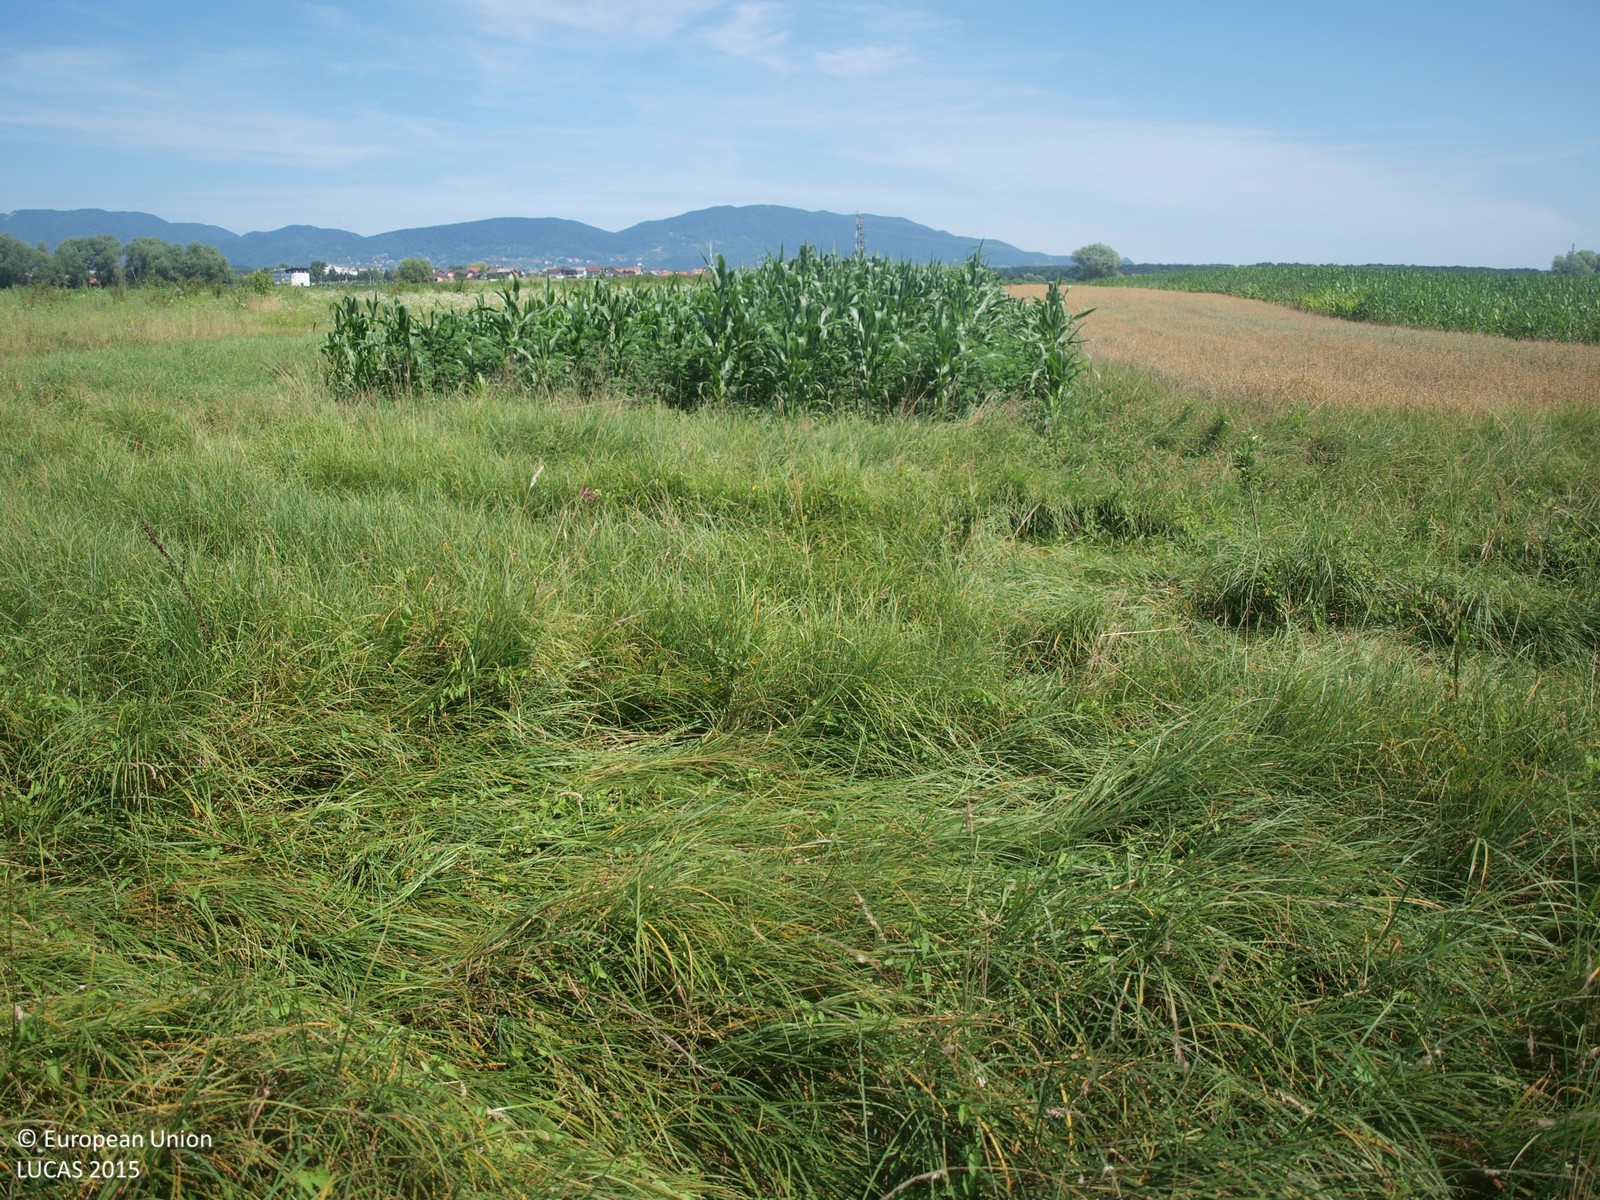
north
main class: Grassland
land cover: Grassland without tree/shrub cover
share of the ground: > 75 %
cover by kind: herbaceous plants 100 %
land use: Agriculture (excluding fallow land and kitchen gardens)
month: July
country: HR
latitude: 45.6598
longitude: 15.6567
